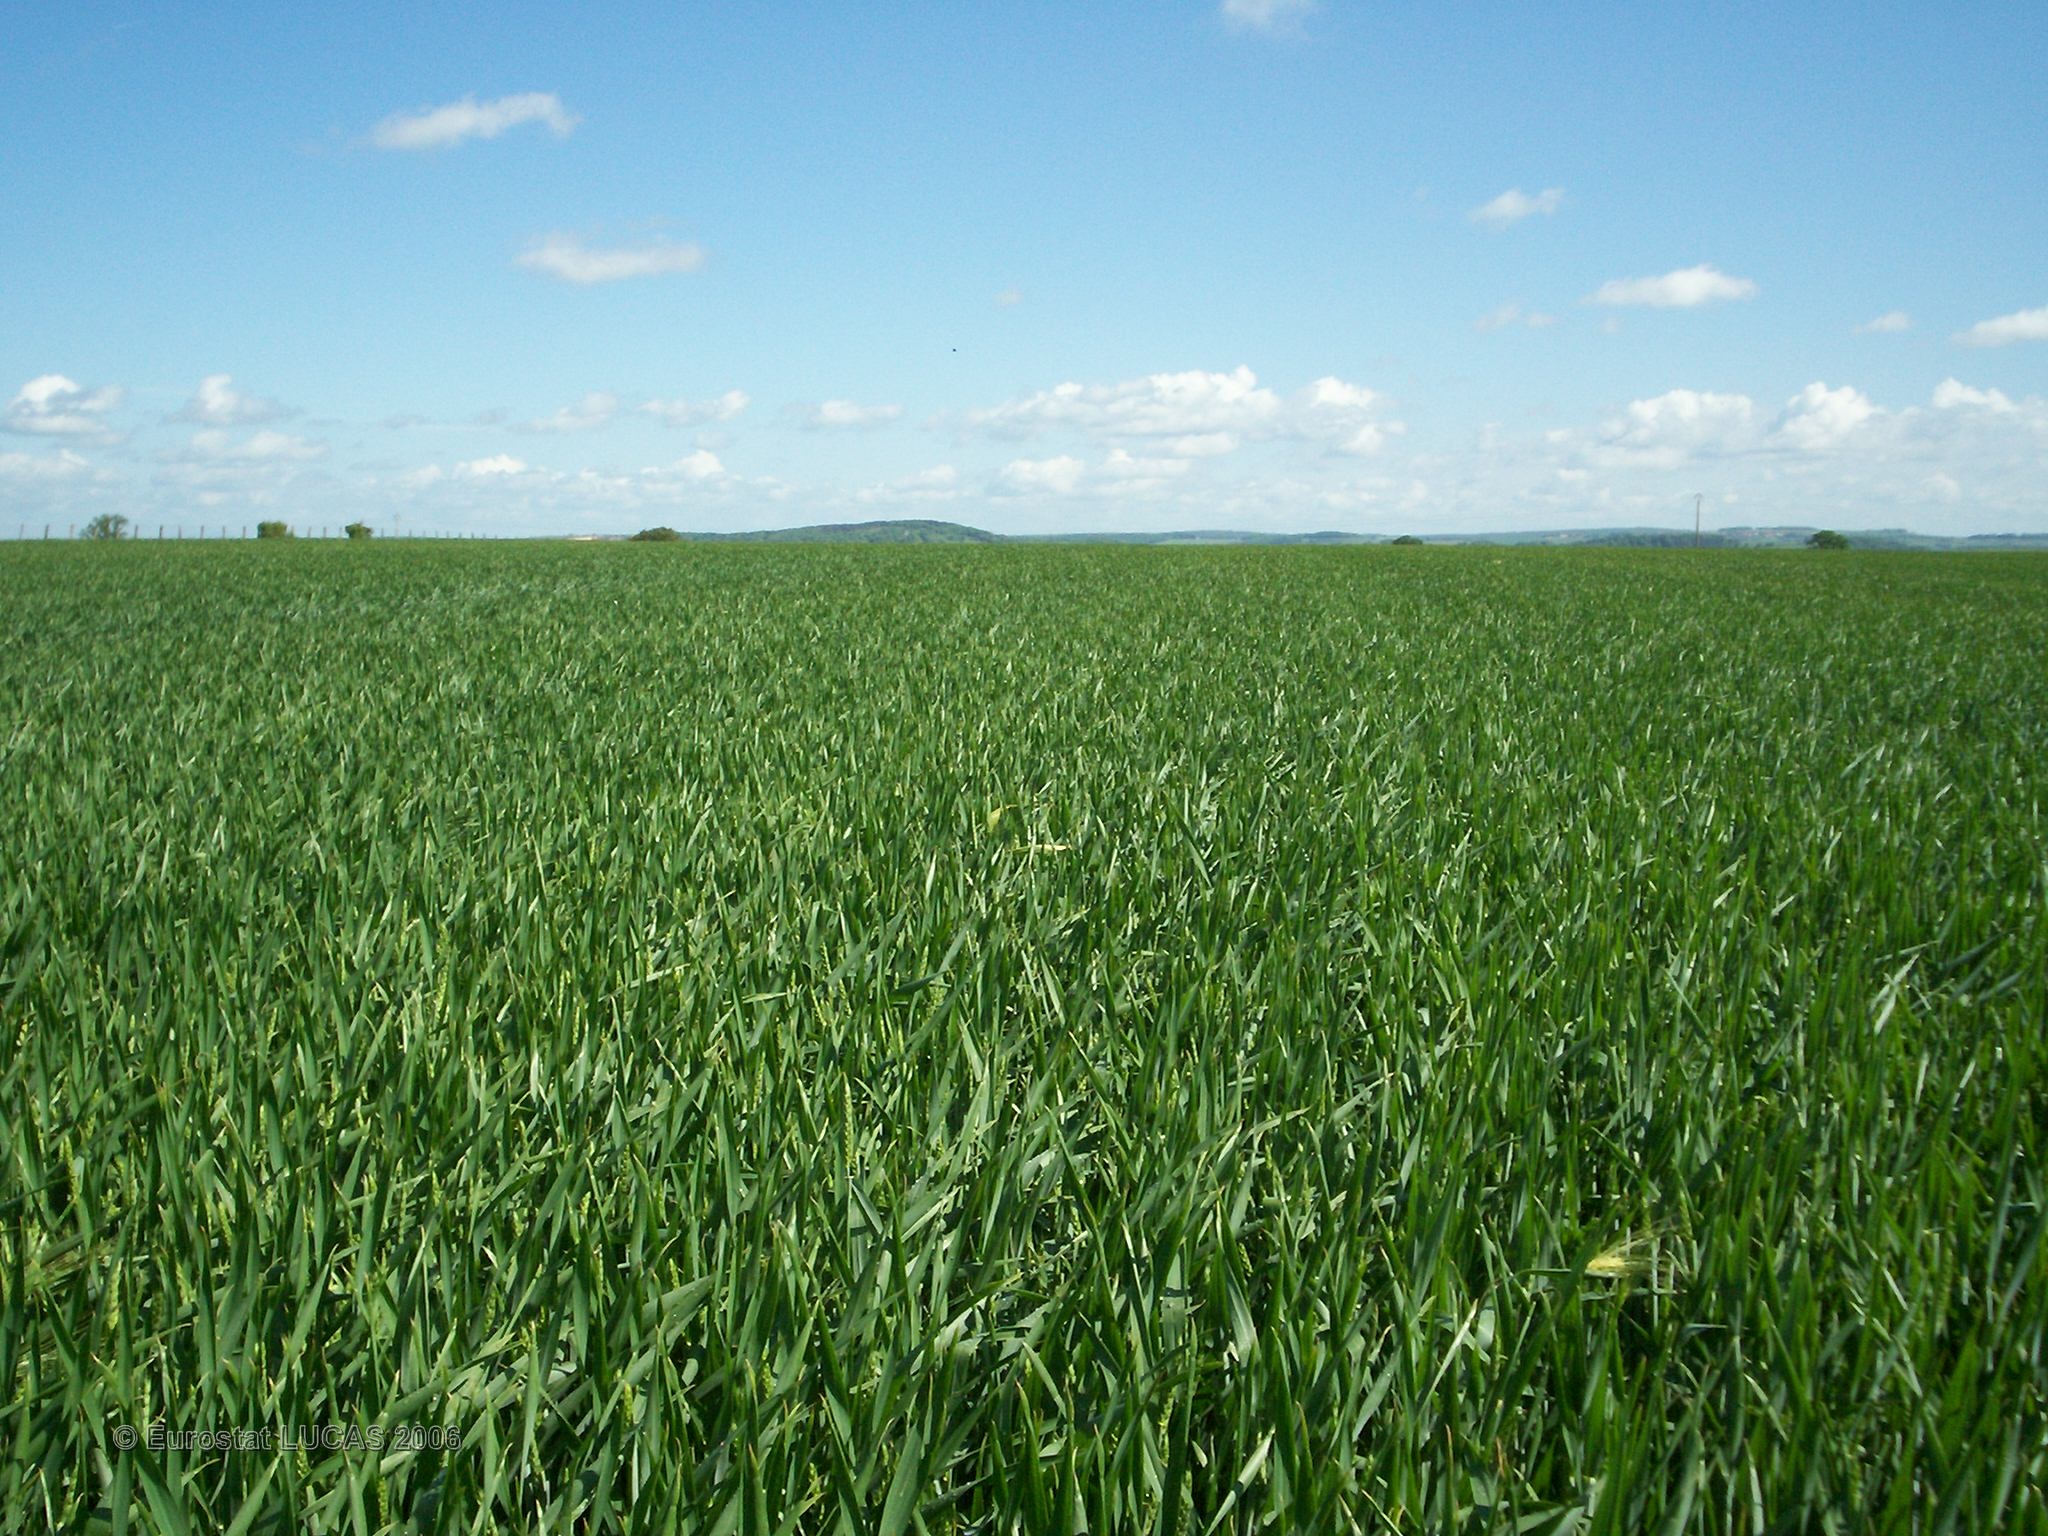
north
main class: Cropland
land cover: Common wheat
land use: Agriculture (excluding fallow land and kitchen gardens)
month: May
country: FR
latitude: 47.4877
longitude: 4.0920
